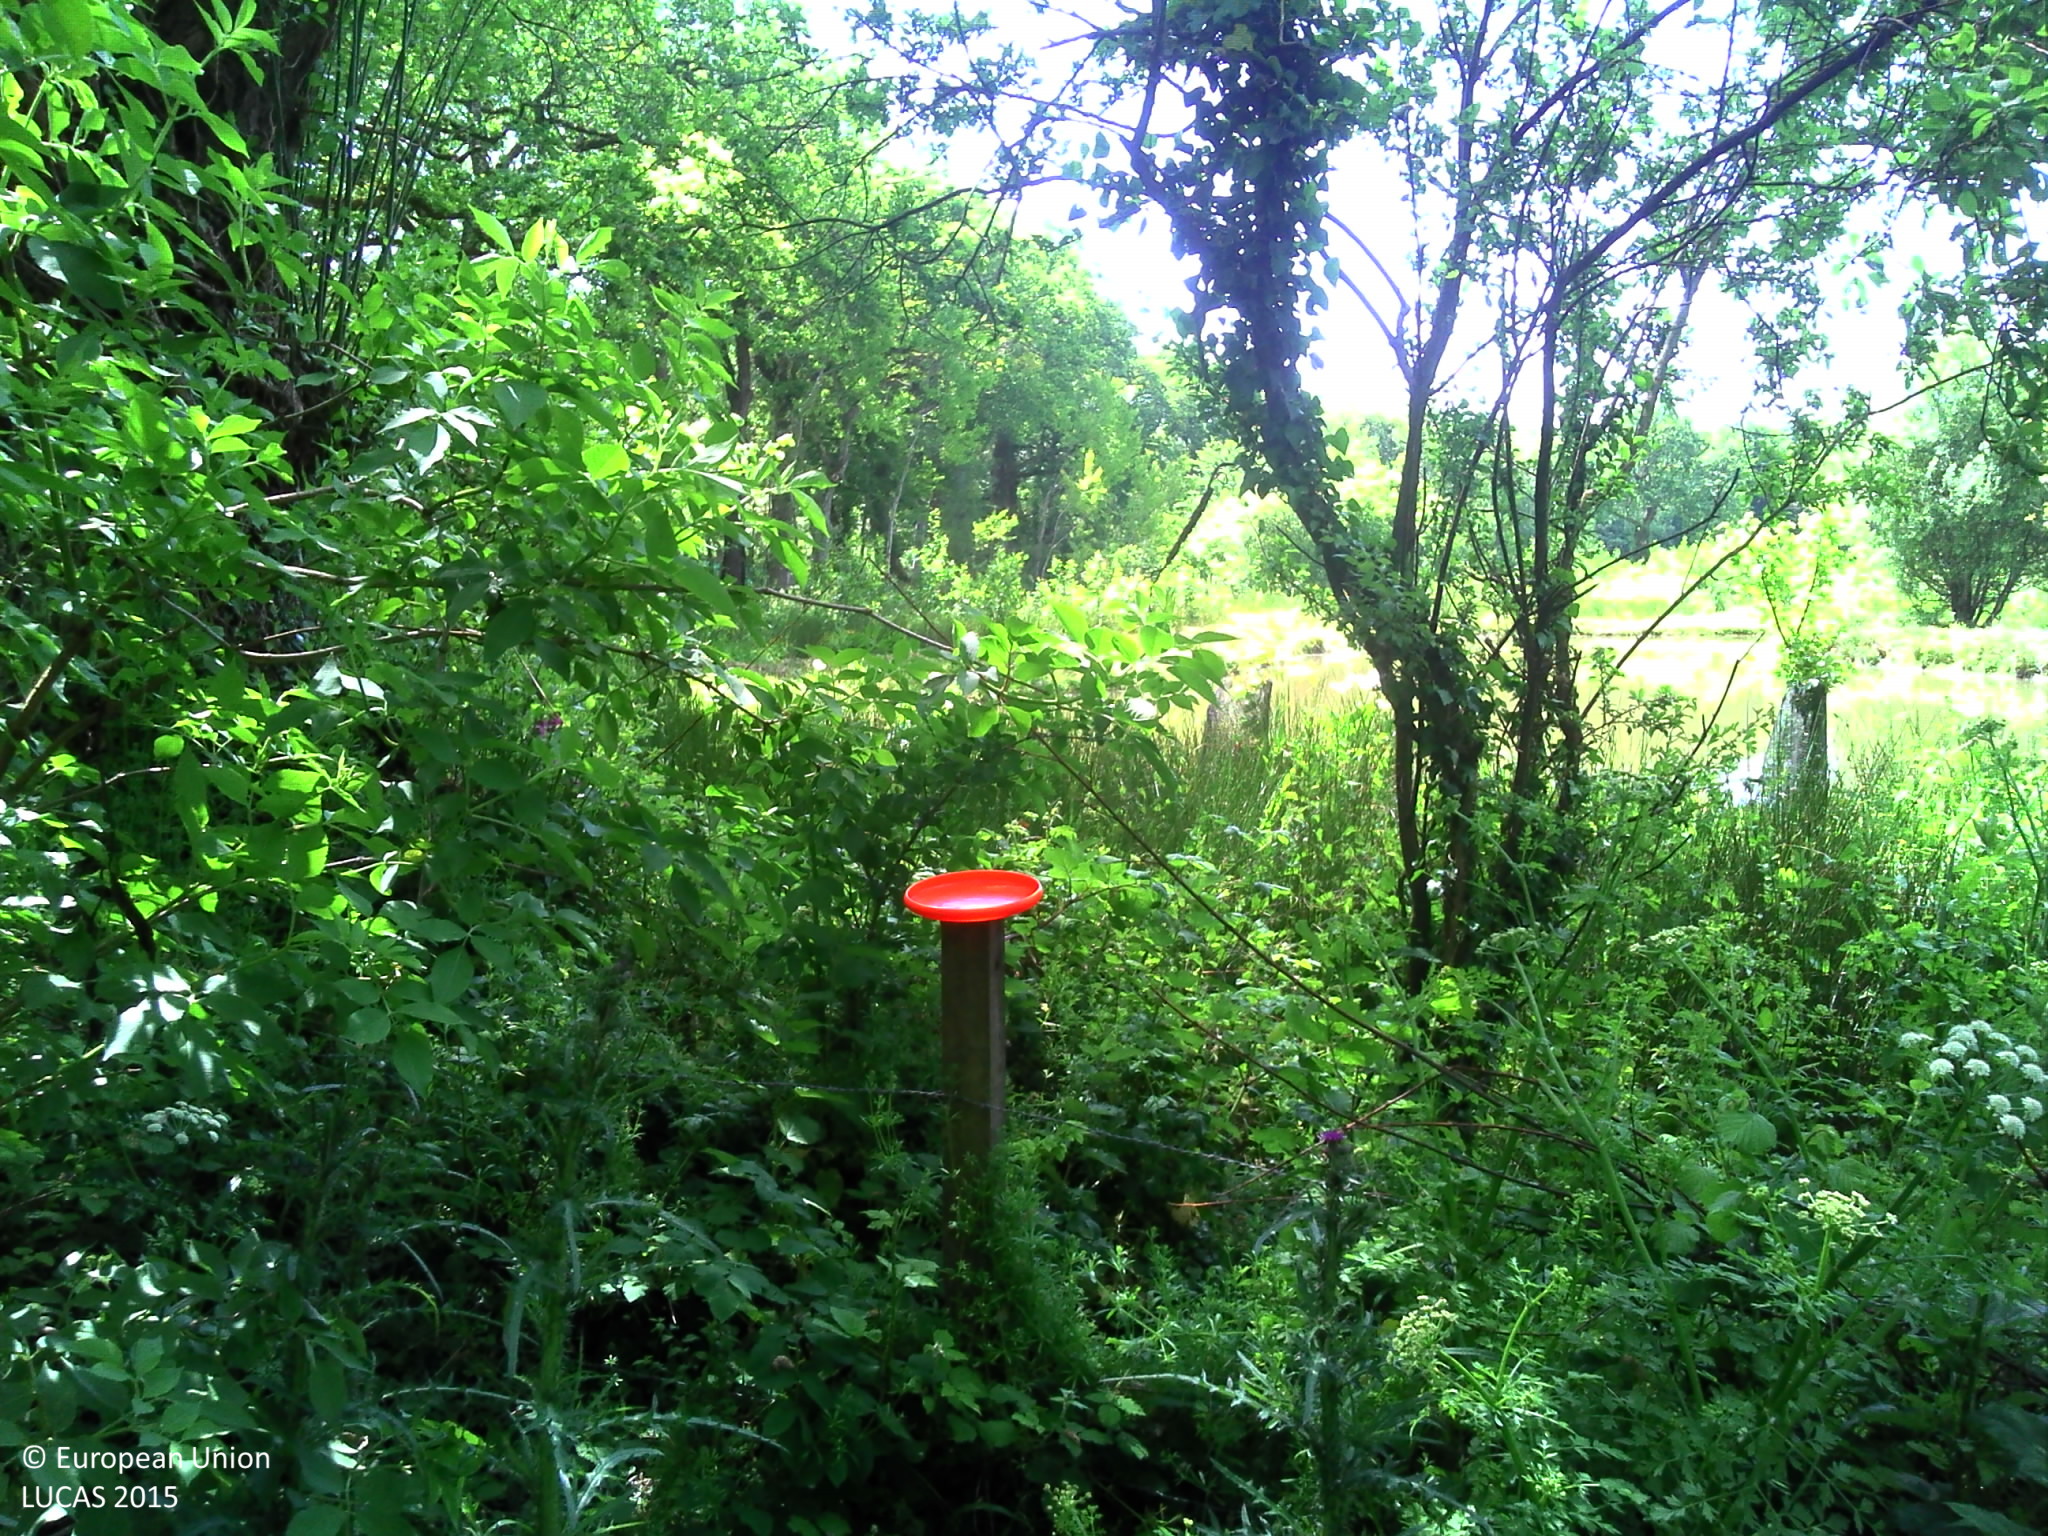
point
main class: Woodland
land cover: Broadleaved woodland
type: exotic forest
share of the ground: > 75 %
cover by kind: broadleaved forest trees 70 %, herbaceous plants 30 %
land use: Forestry
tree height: > 5 m
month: June
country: FR
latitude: 49.4365
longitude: -1.6768
